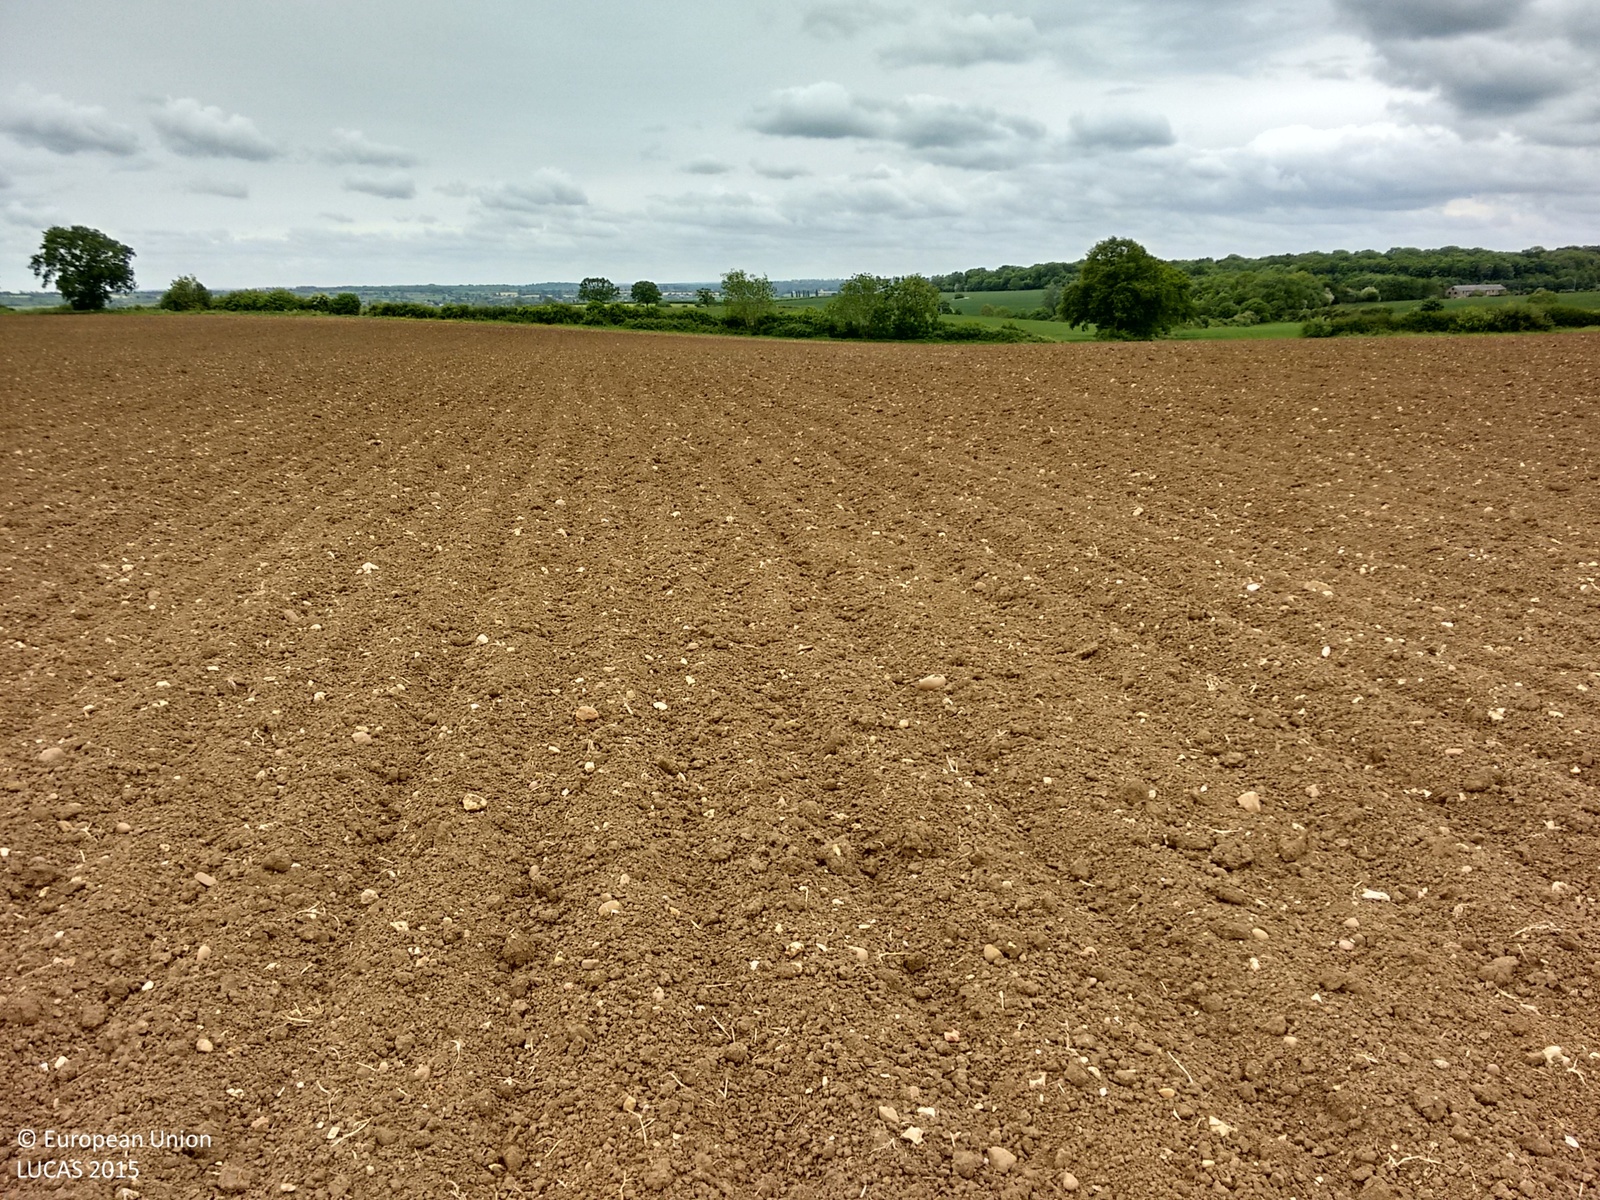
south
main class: Cropland
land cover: Dry pulses
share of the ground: < 10 %
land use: Agriculture (excluding fallow land and kitchen gardens)
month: June
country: GB
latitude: 52.2258
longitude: -0.6242
